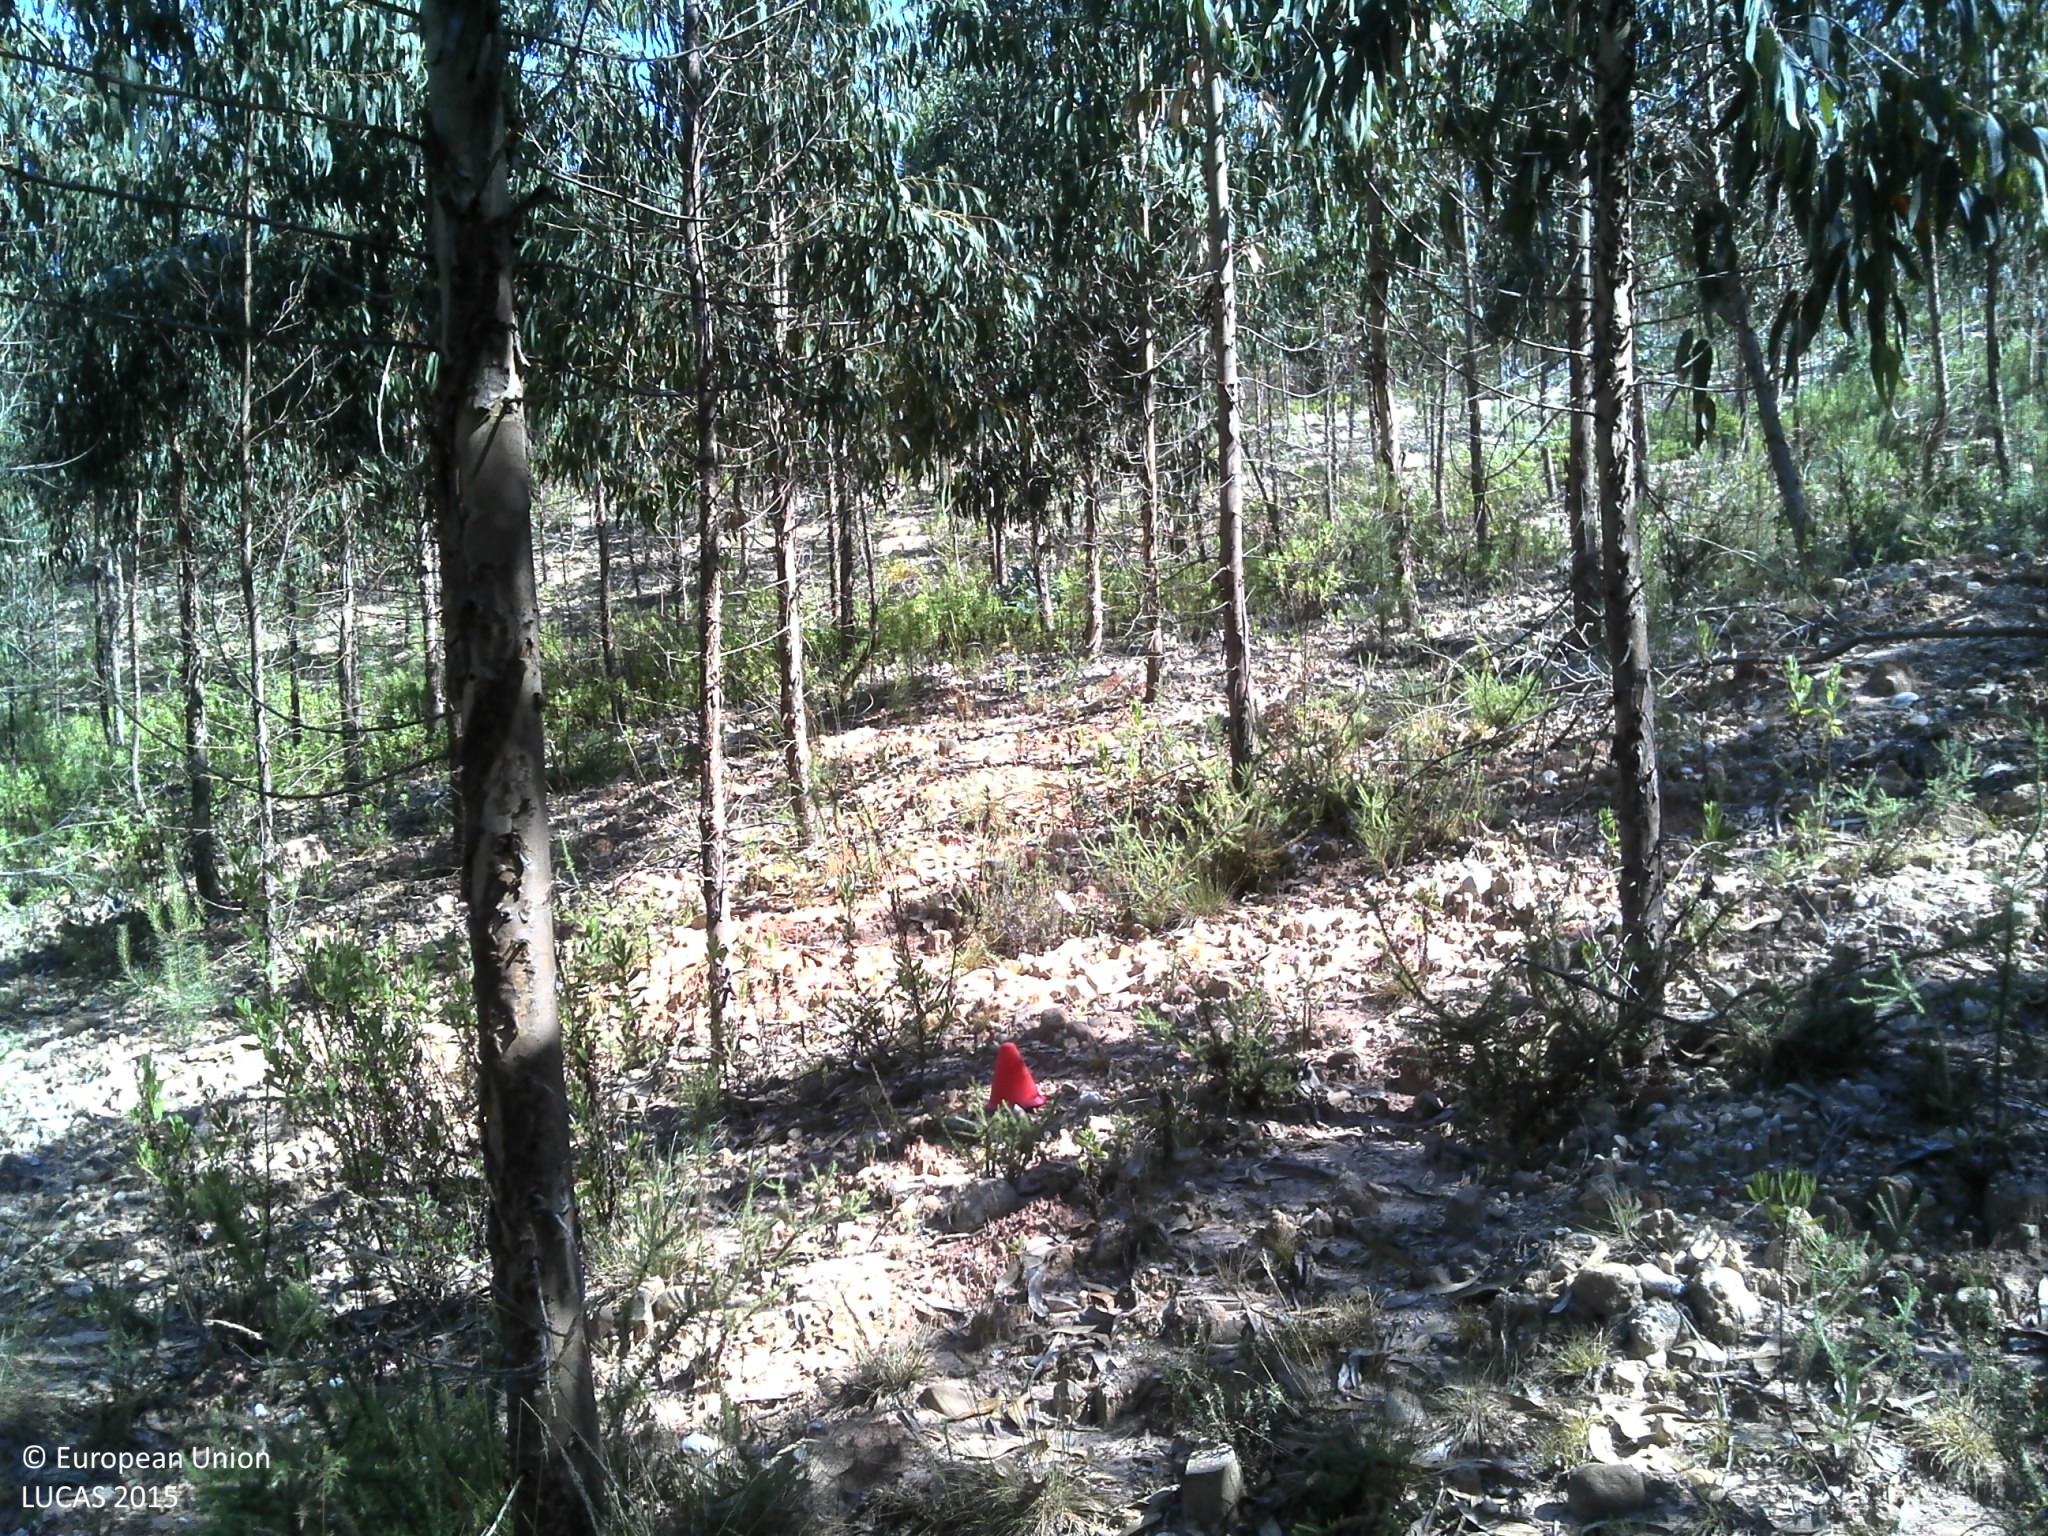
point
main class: Woodland
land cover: Broadleaved woodland
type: exotic forest
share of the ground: 50 - 75 %
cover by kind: broadleaved forest trees 60 %, unconsolidated bare surface 25 %, shrubs 15 %
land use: Forestry
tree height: > 5 m
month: June
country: PT
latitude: 39.6944
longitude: -8.8735
